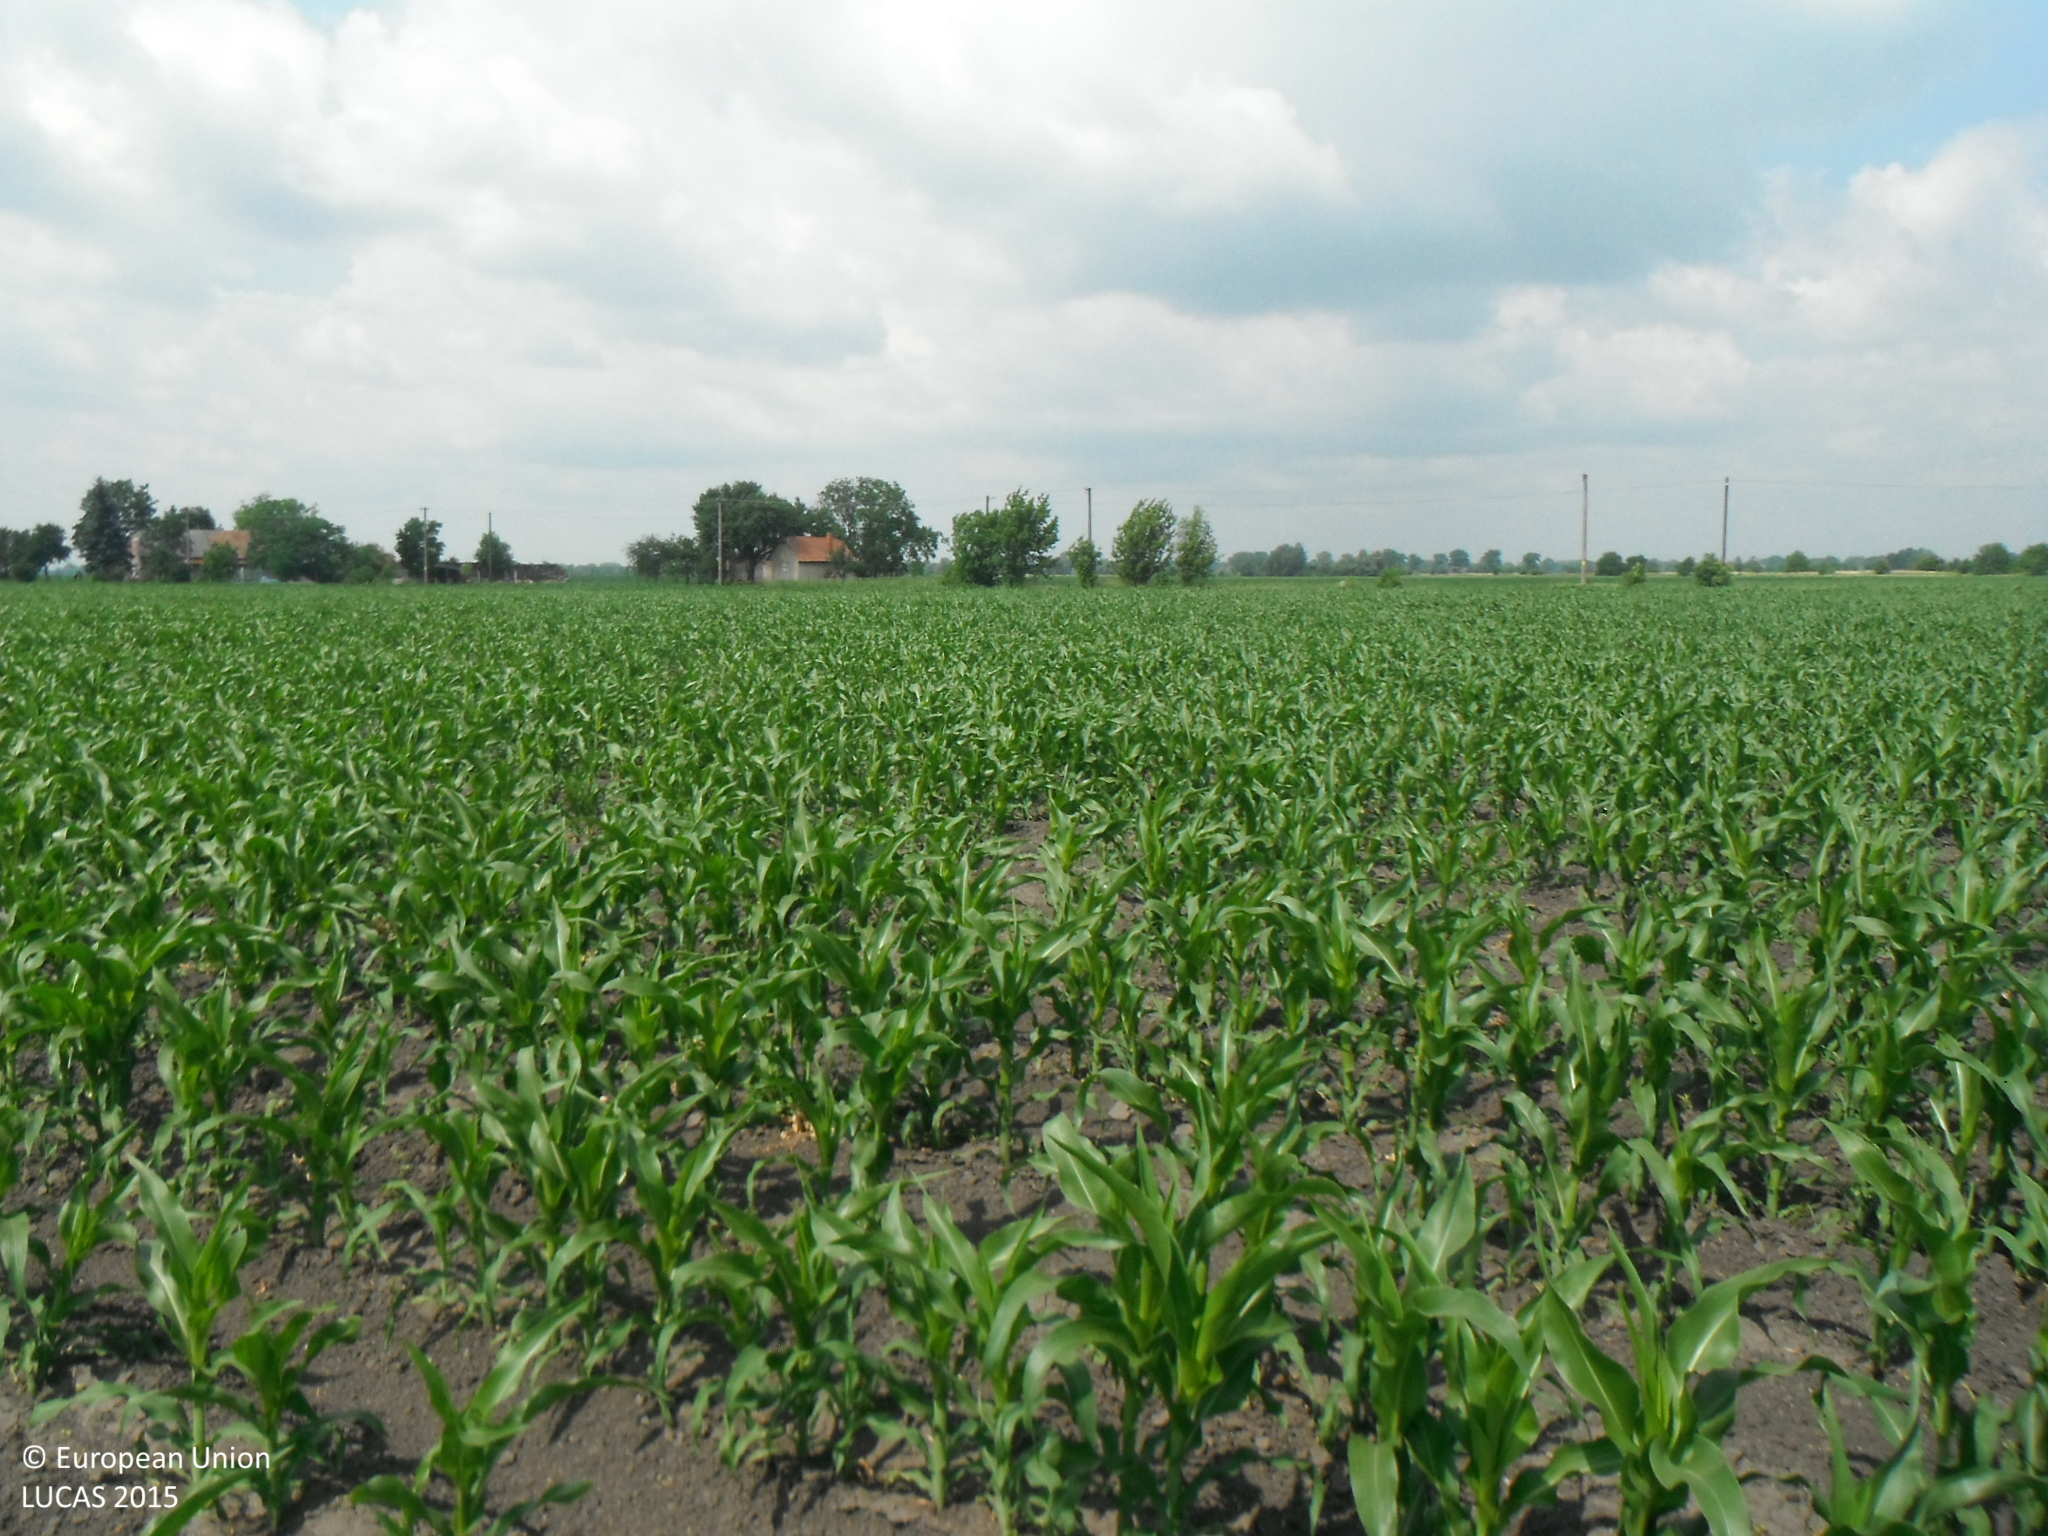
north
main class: Cropland
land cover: Maize
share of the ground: 50 - 75 %
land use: Agriculture (excluding fallow land and kitchen gardens)
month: June
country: SK
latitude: 47.8448
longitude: 17.9624
